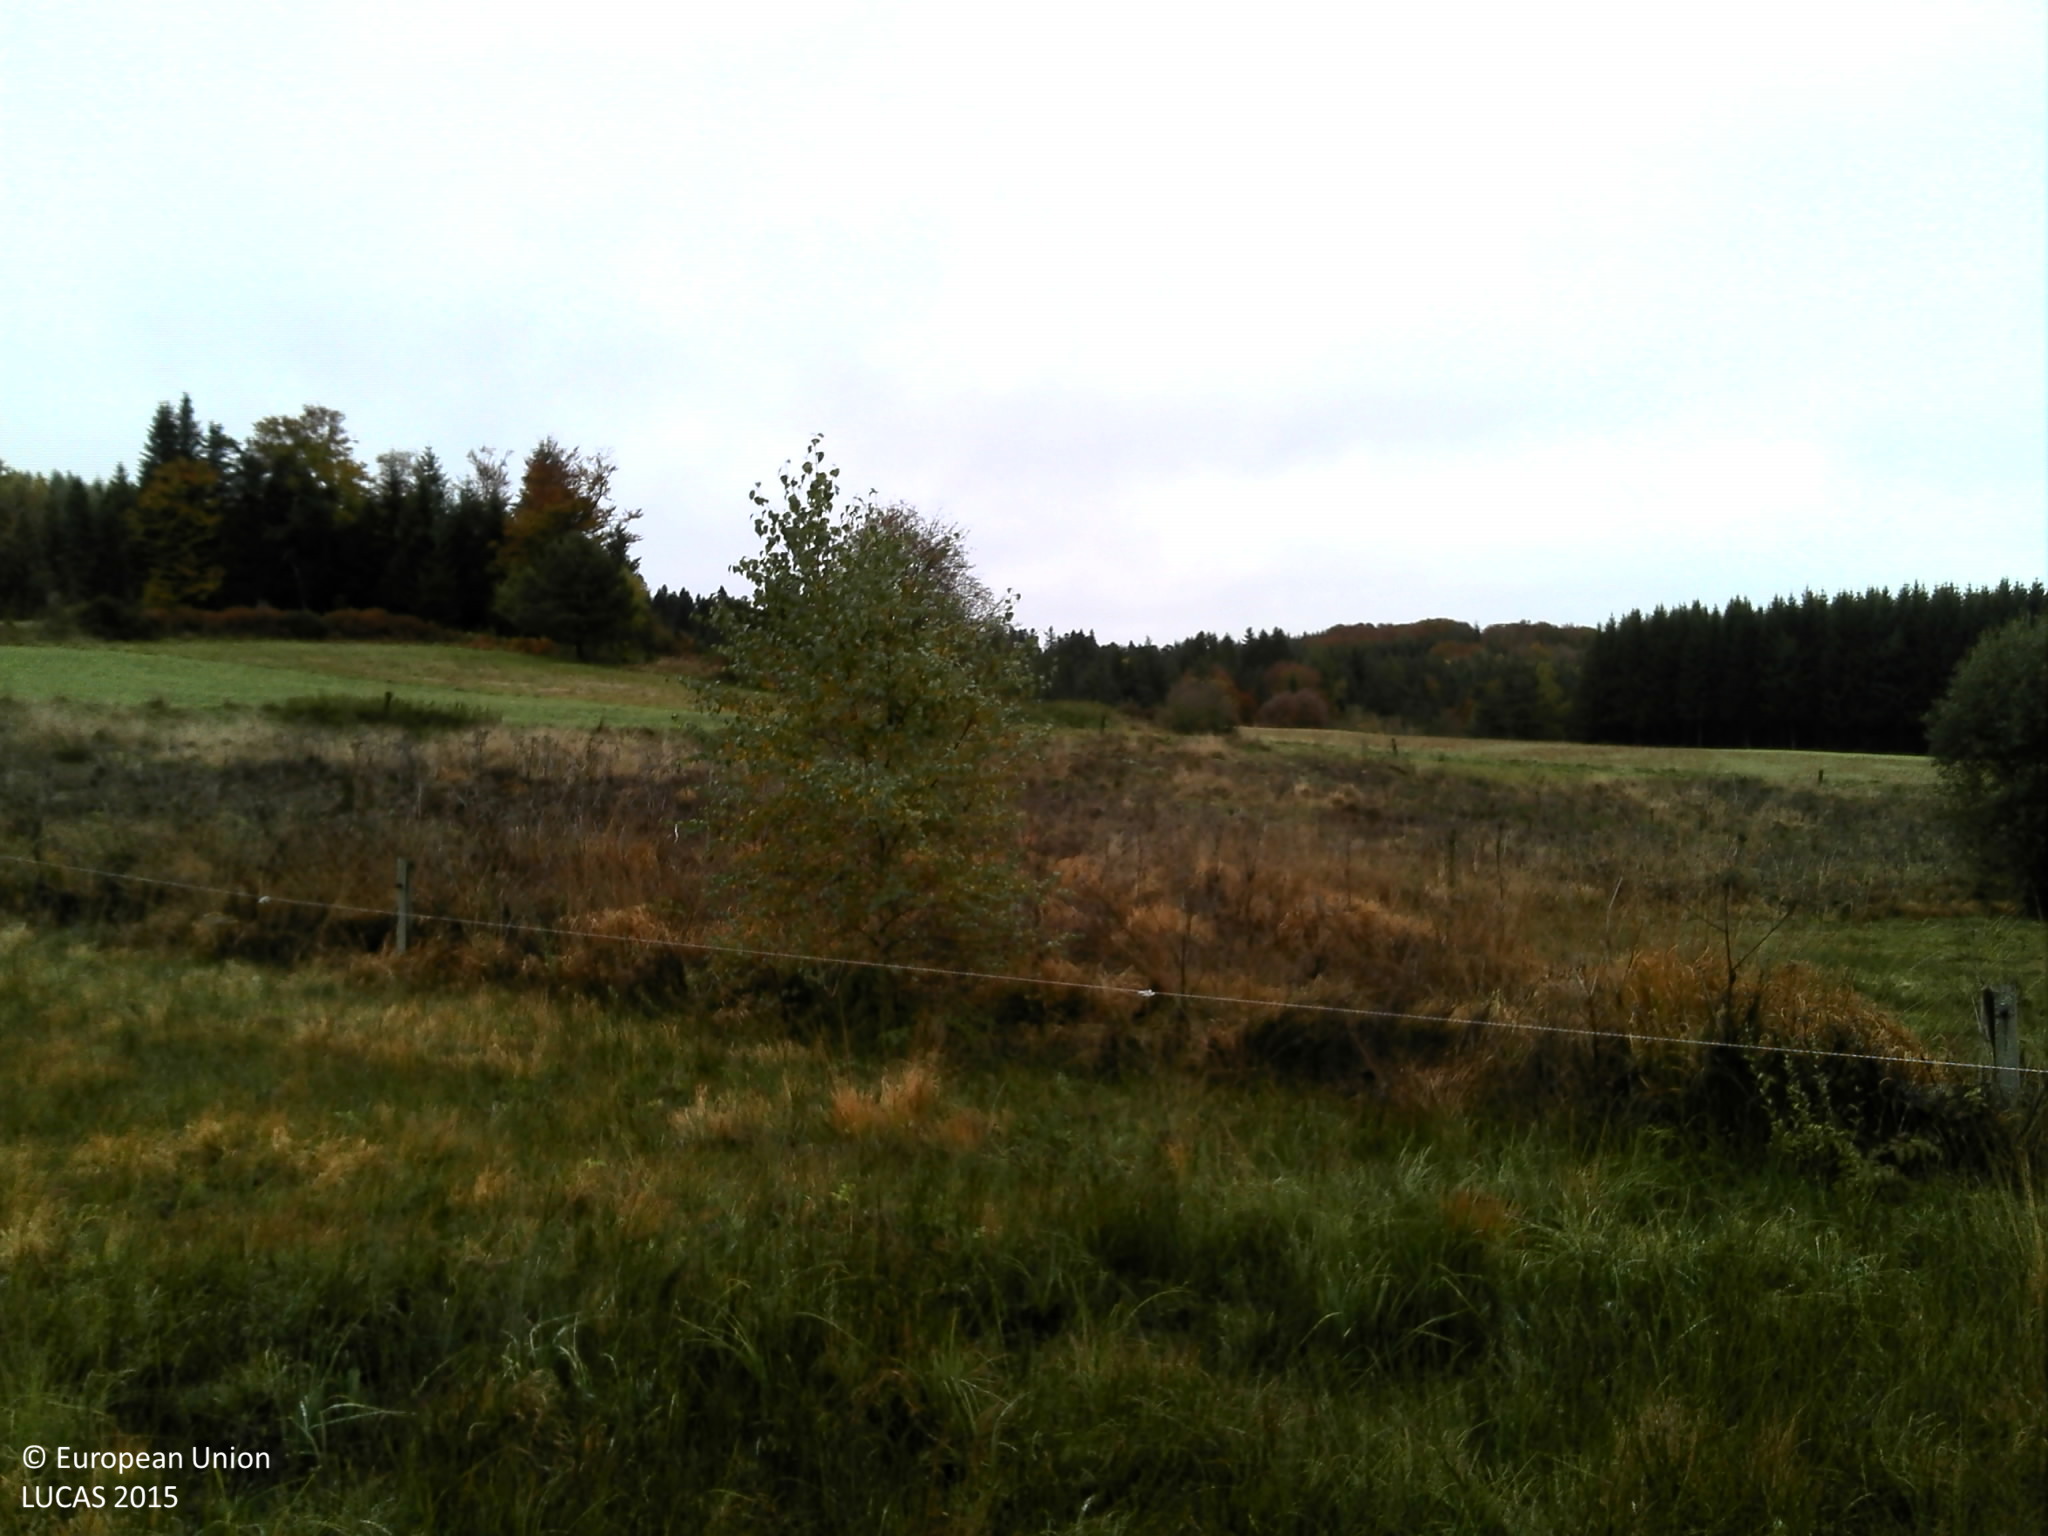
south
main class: Grassland
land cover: Grassland without tree/shrub cover
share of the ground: > 75 %
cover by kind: herbaceous plants 100 %
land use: Agriculture (excluding fallow land and kitchen gardens)
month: October
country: FR
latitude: 45.4143
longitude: 3.8310
